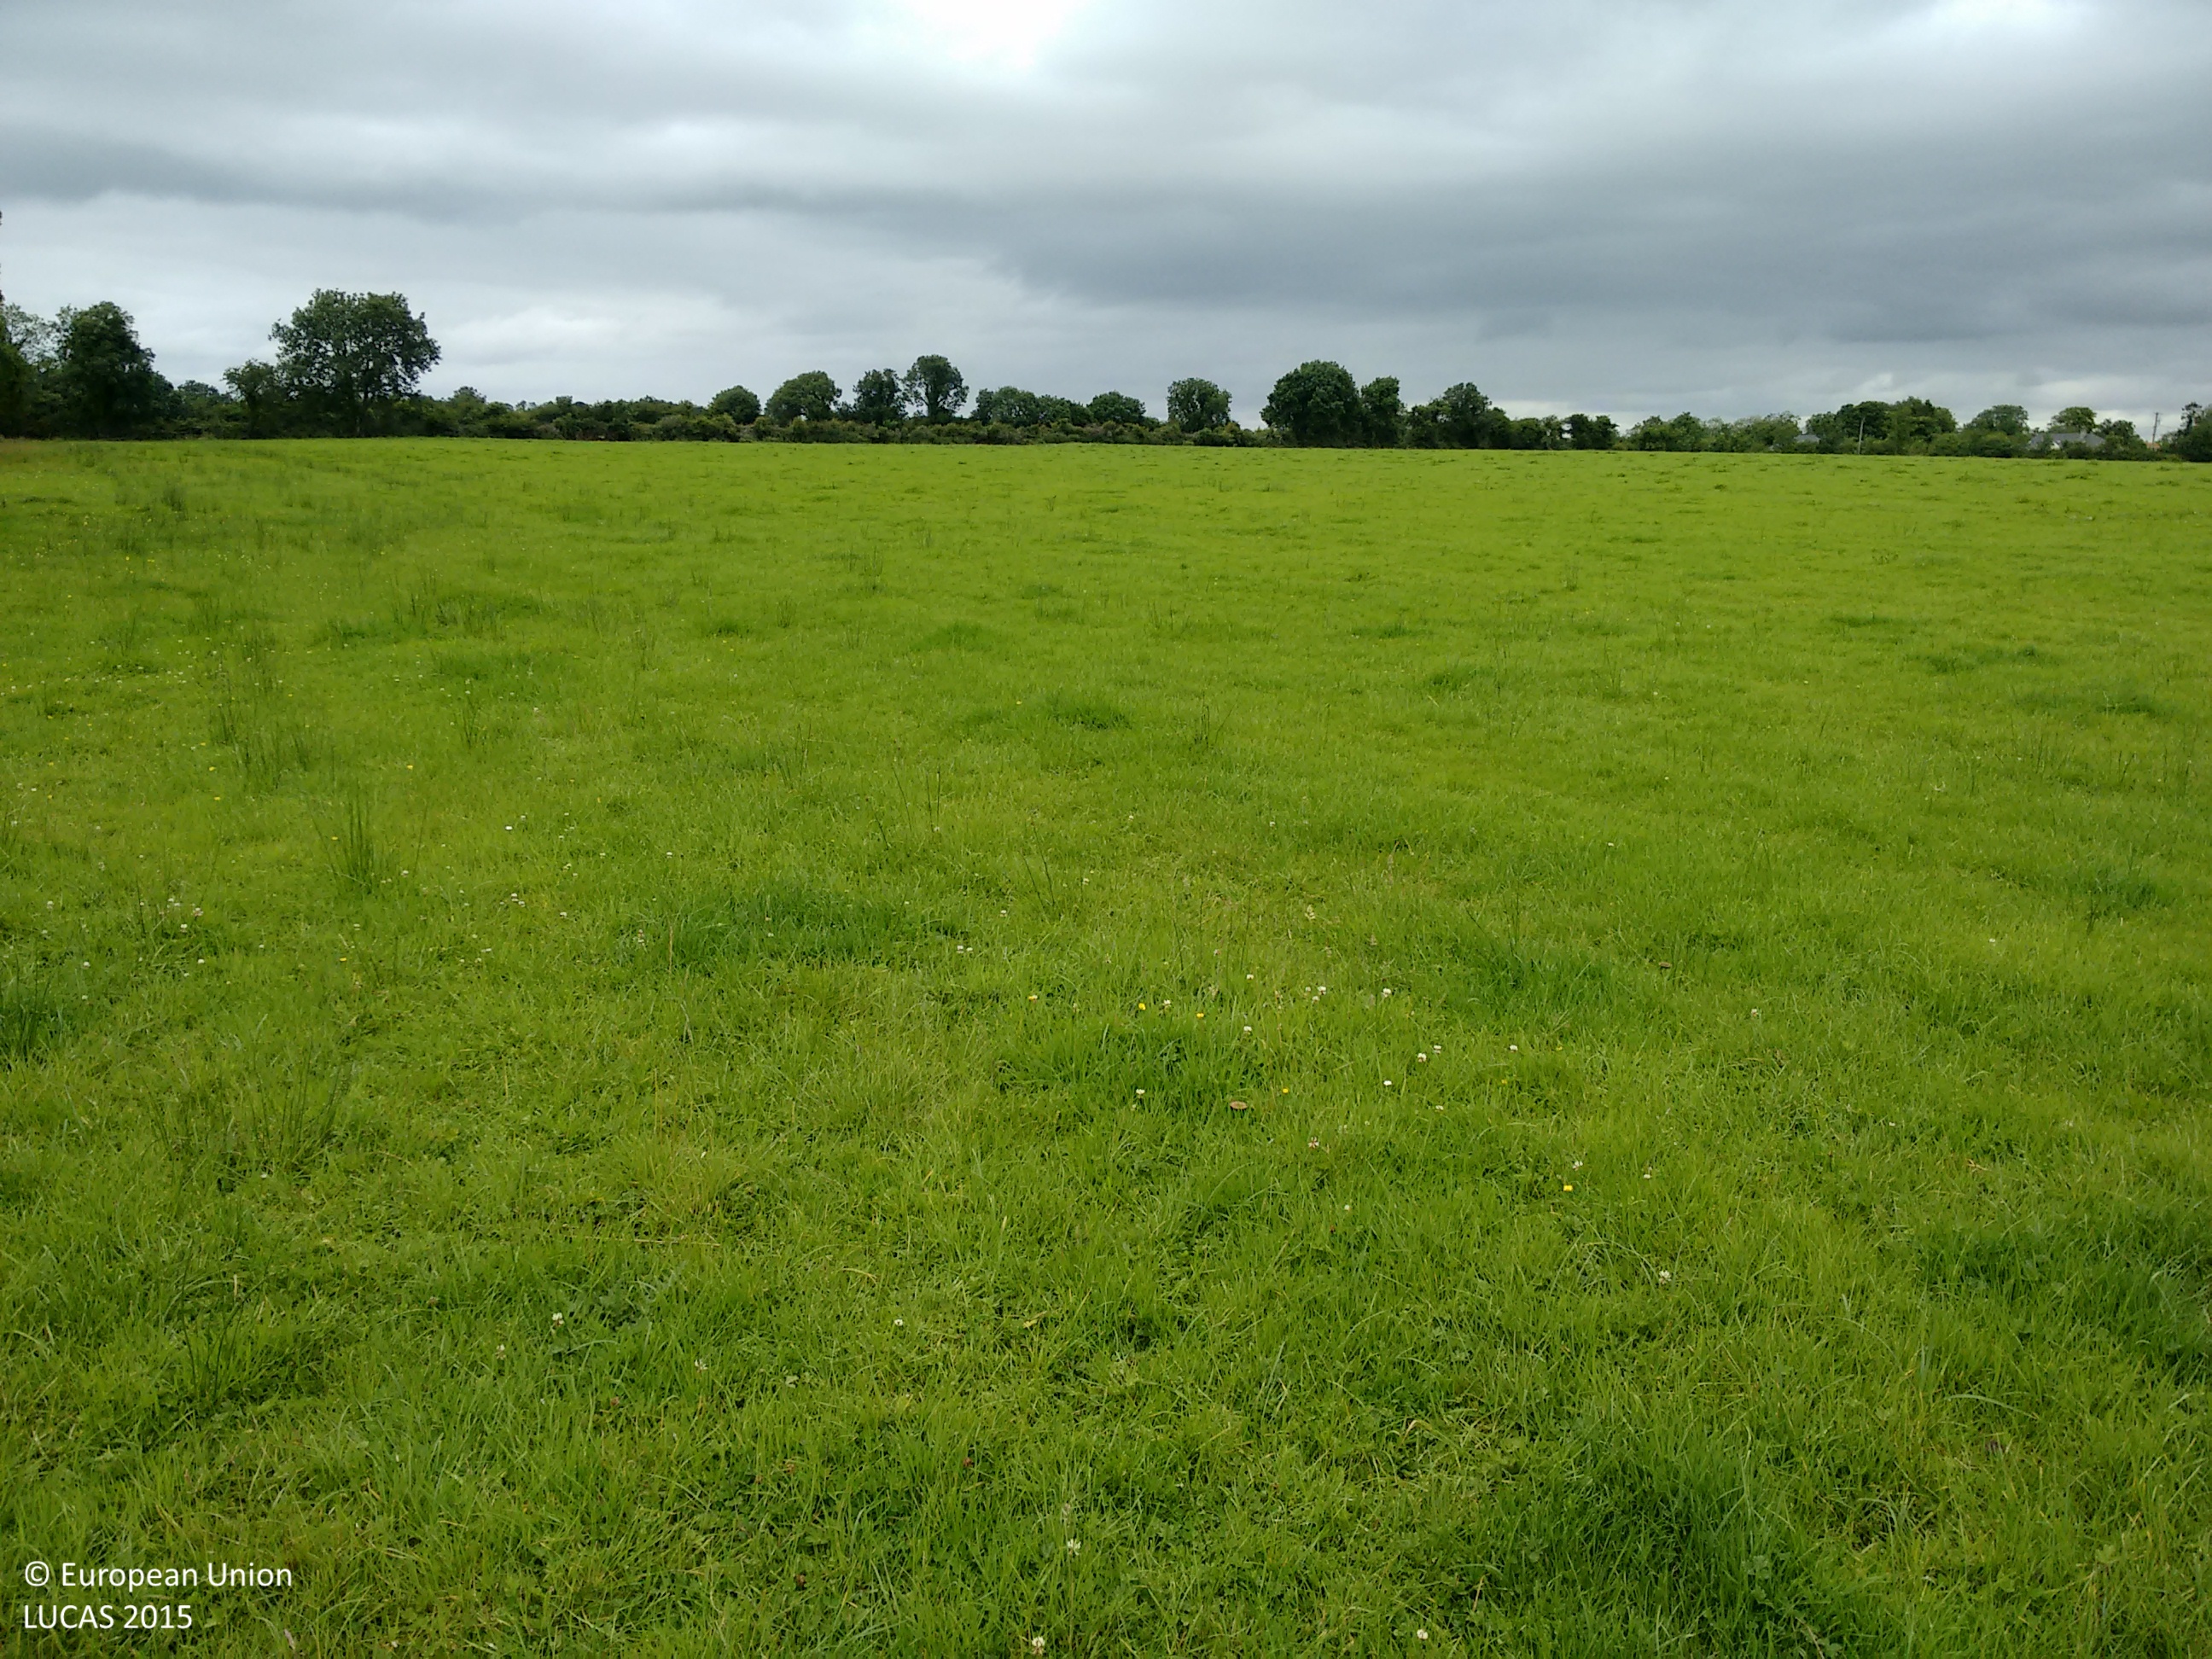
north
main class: Grassland
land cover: Grassland without tree/shrub cover
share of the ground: > 75 %
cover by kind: herbaceous plants 95 %, shrubs 5 %
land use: Agriculture (excluding fallow land and kitchen gardens)
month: July
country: IE
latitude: 53.6761
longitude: -7.6474
